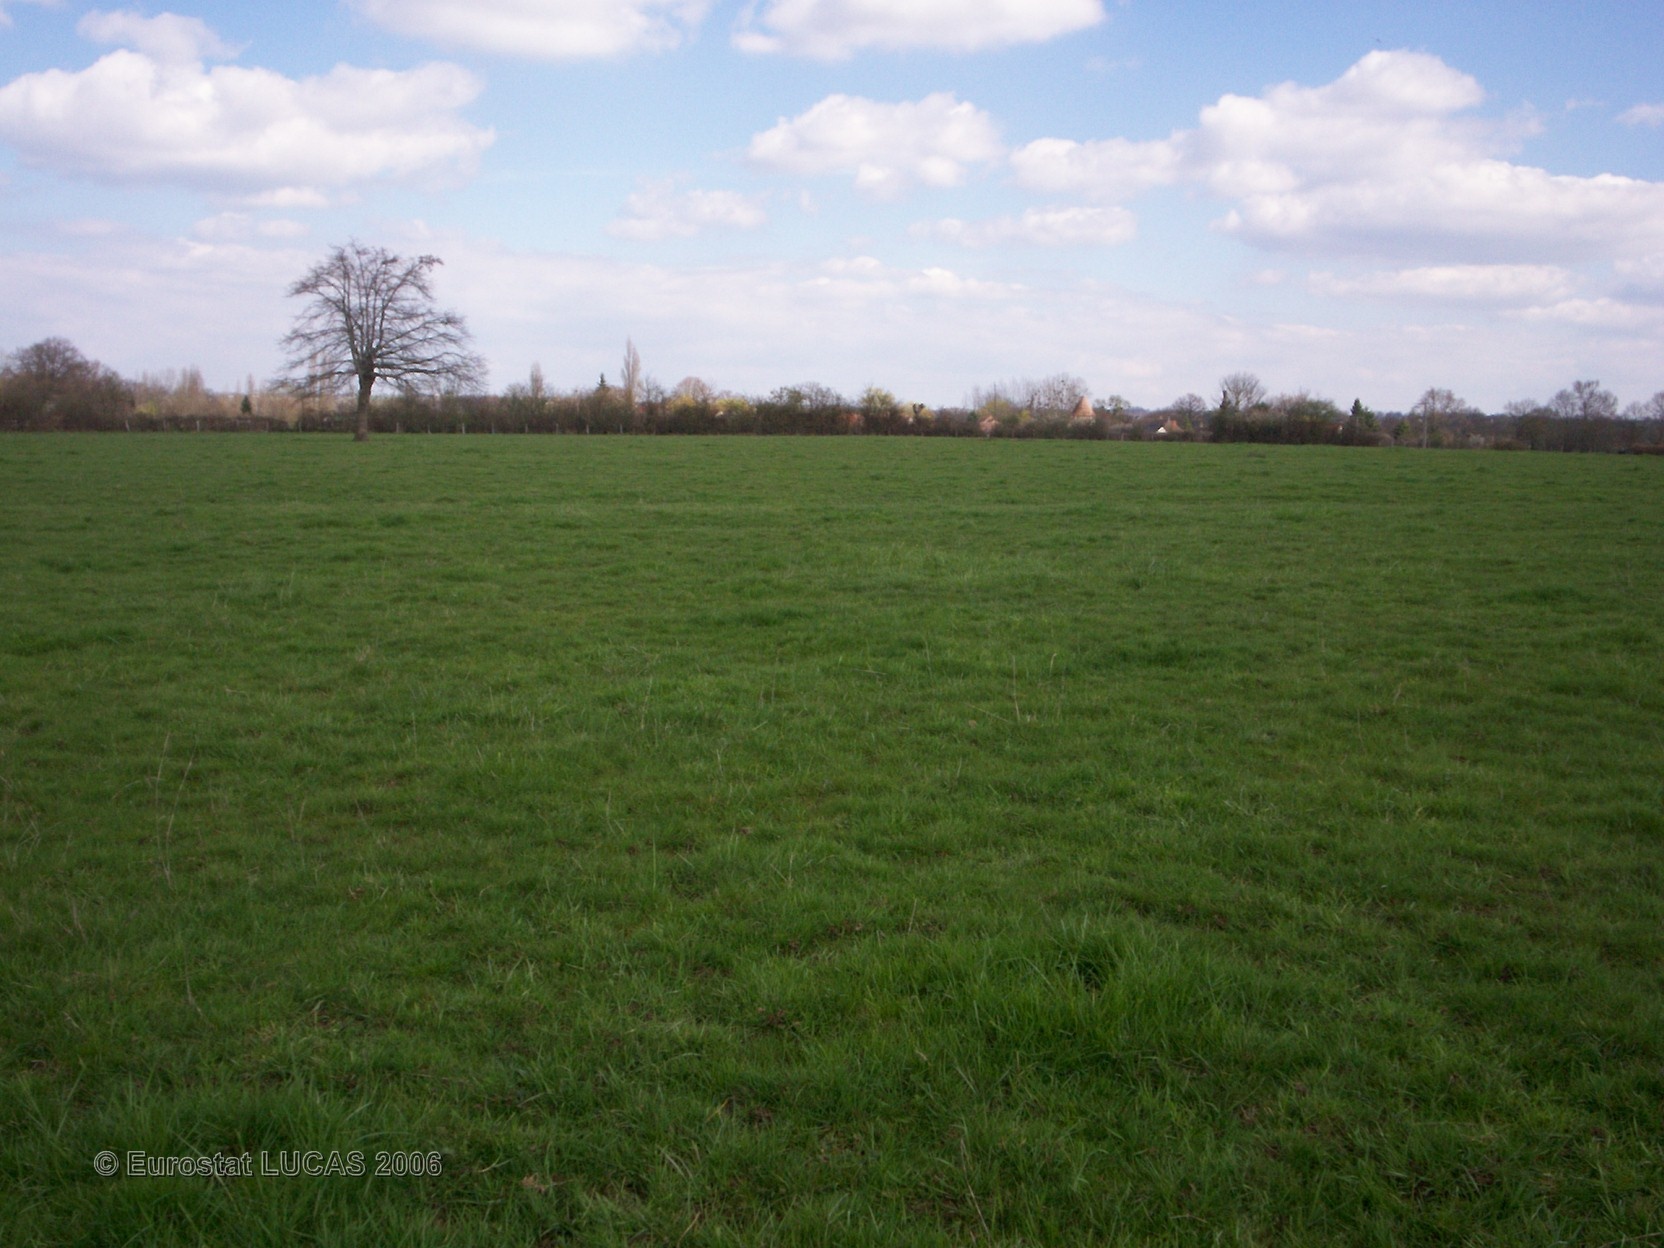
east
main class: Grassland
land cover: Grassland without tree/shrub cover
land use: Agriculture (excluding fallow land and kitchen gardens)
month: April
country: FR
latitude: 46.7948
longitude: 3.0660
